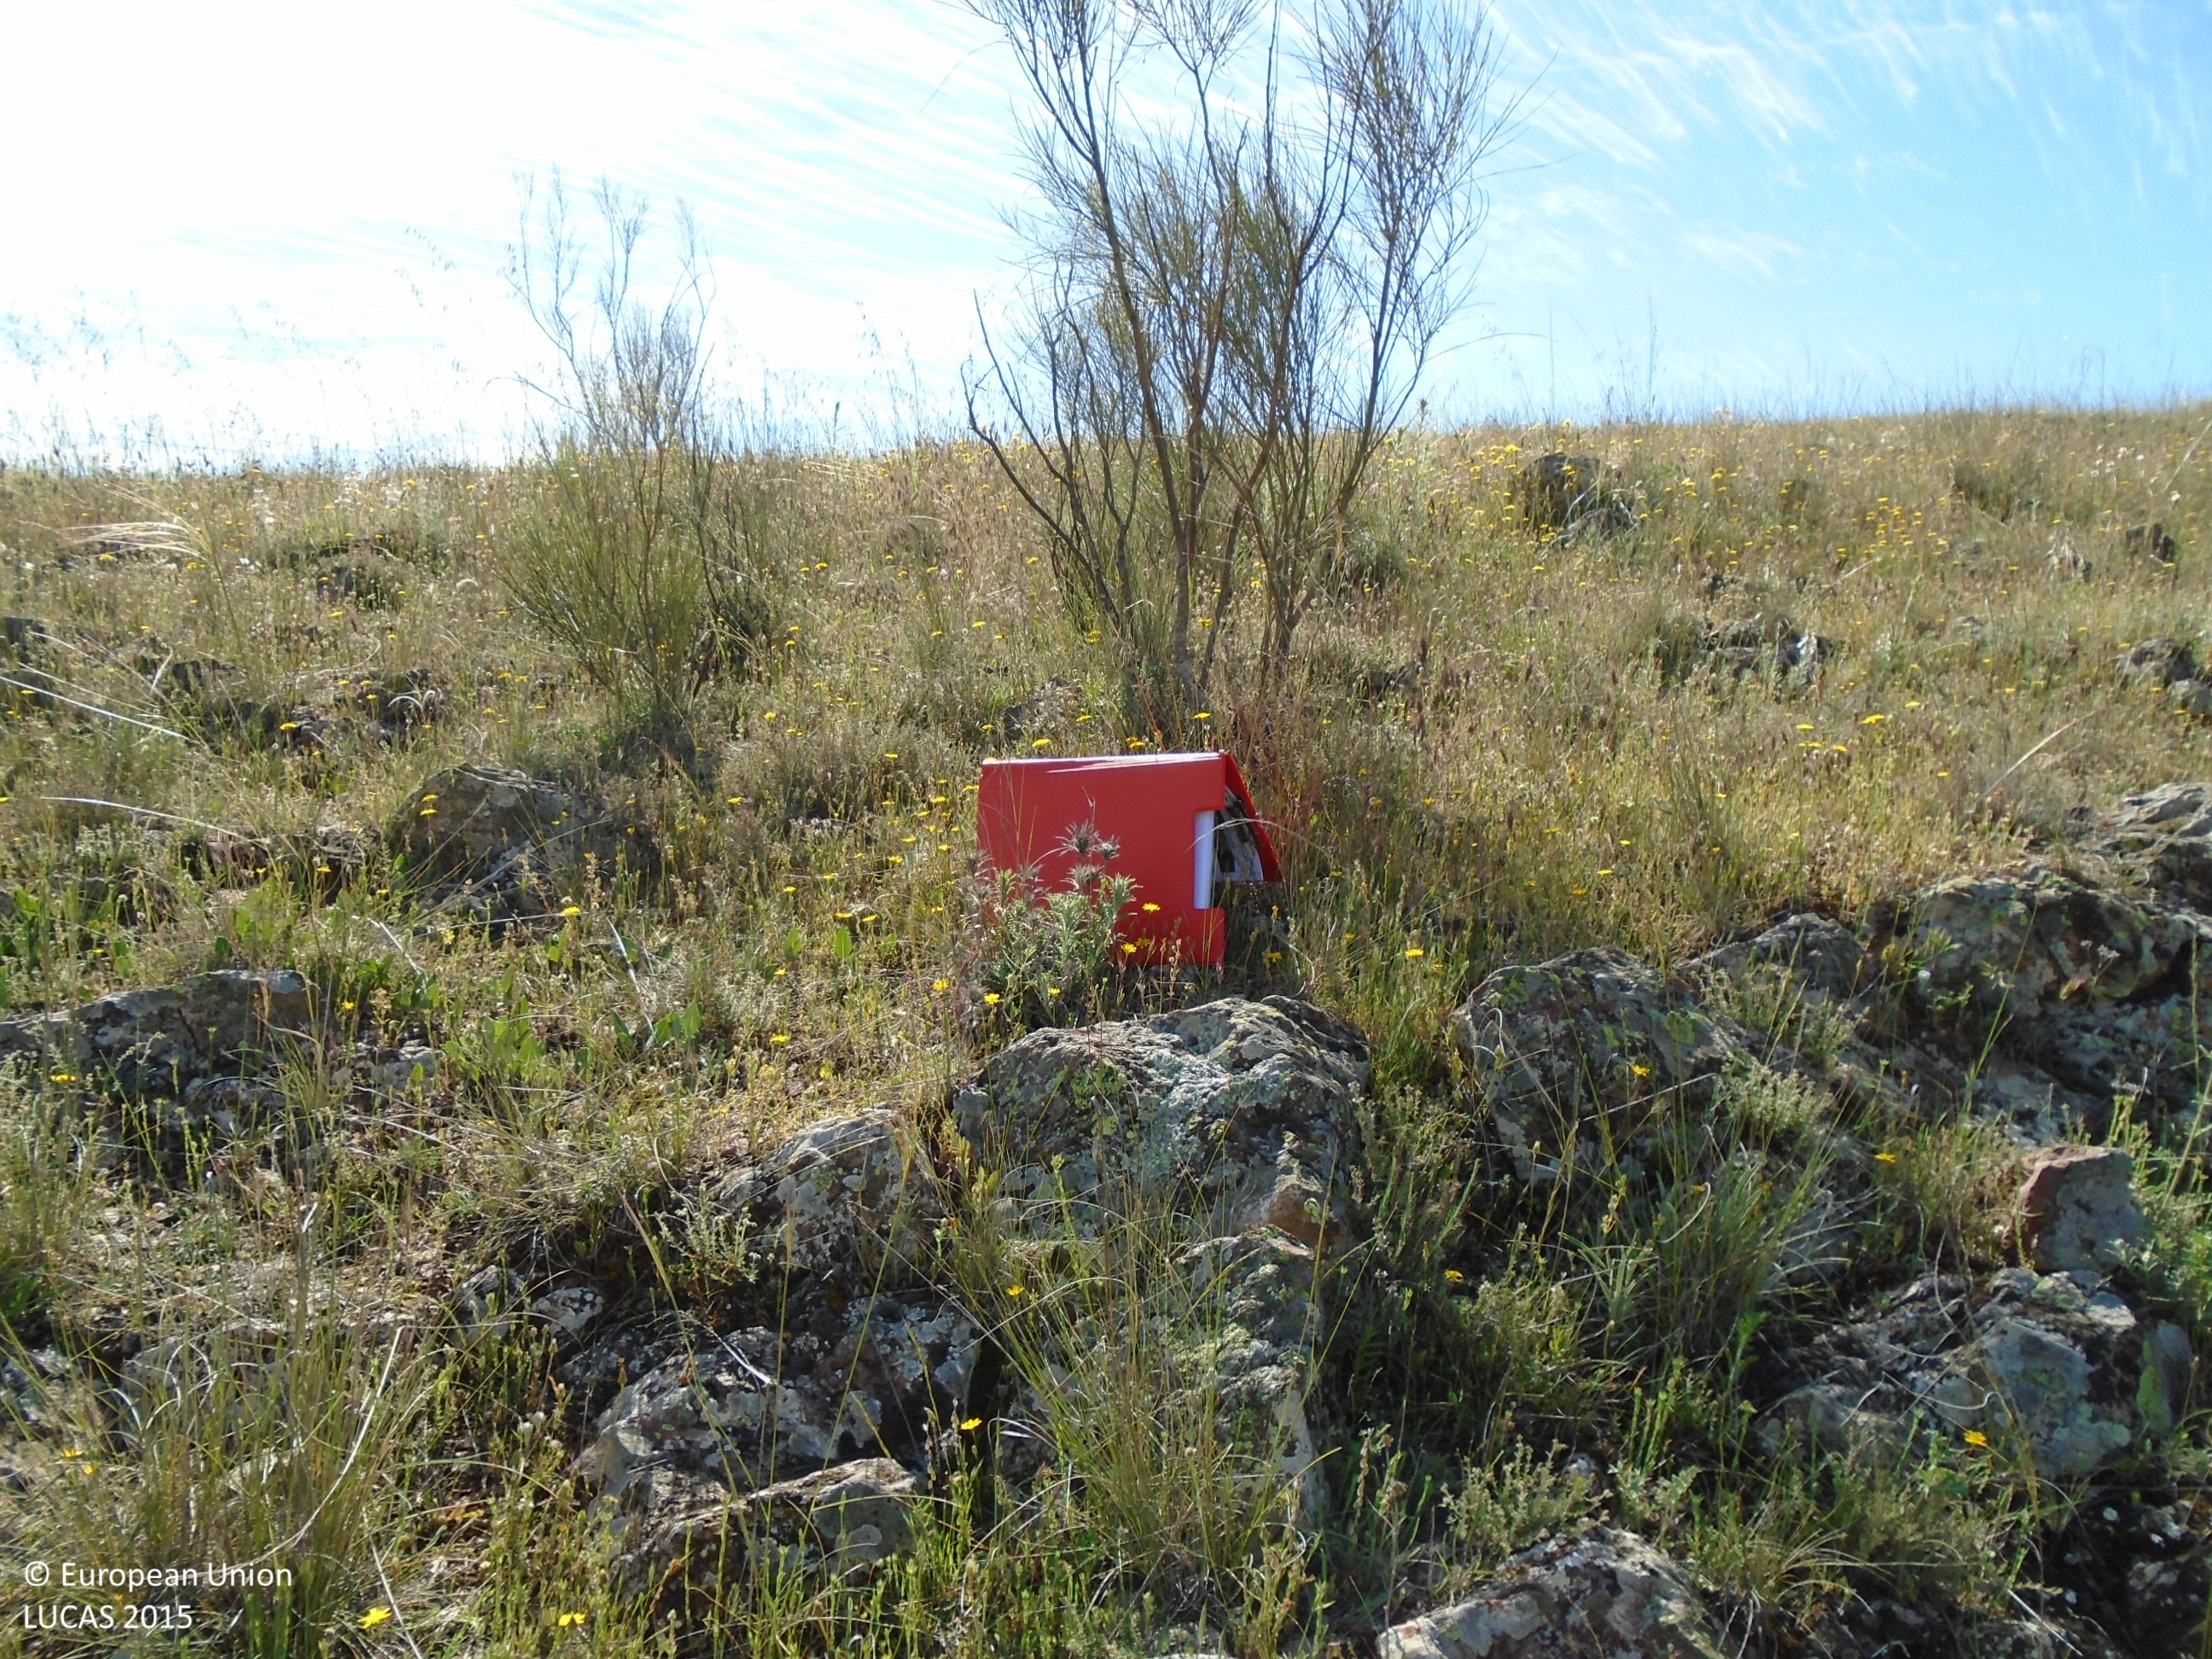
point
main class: Grassland
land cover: Grassland without tree/shrub cover
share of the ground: > 75 %
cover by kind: herbaceous plants 90 %, shrubs 5 %, consolidated bare surface 5 %
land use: Semi-natural and natural areas not in use
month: May
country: ES
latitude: 39.6417
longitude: -3.6248
